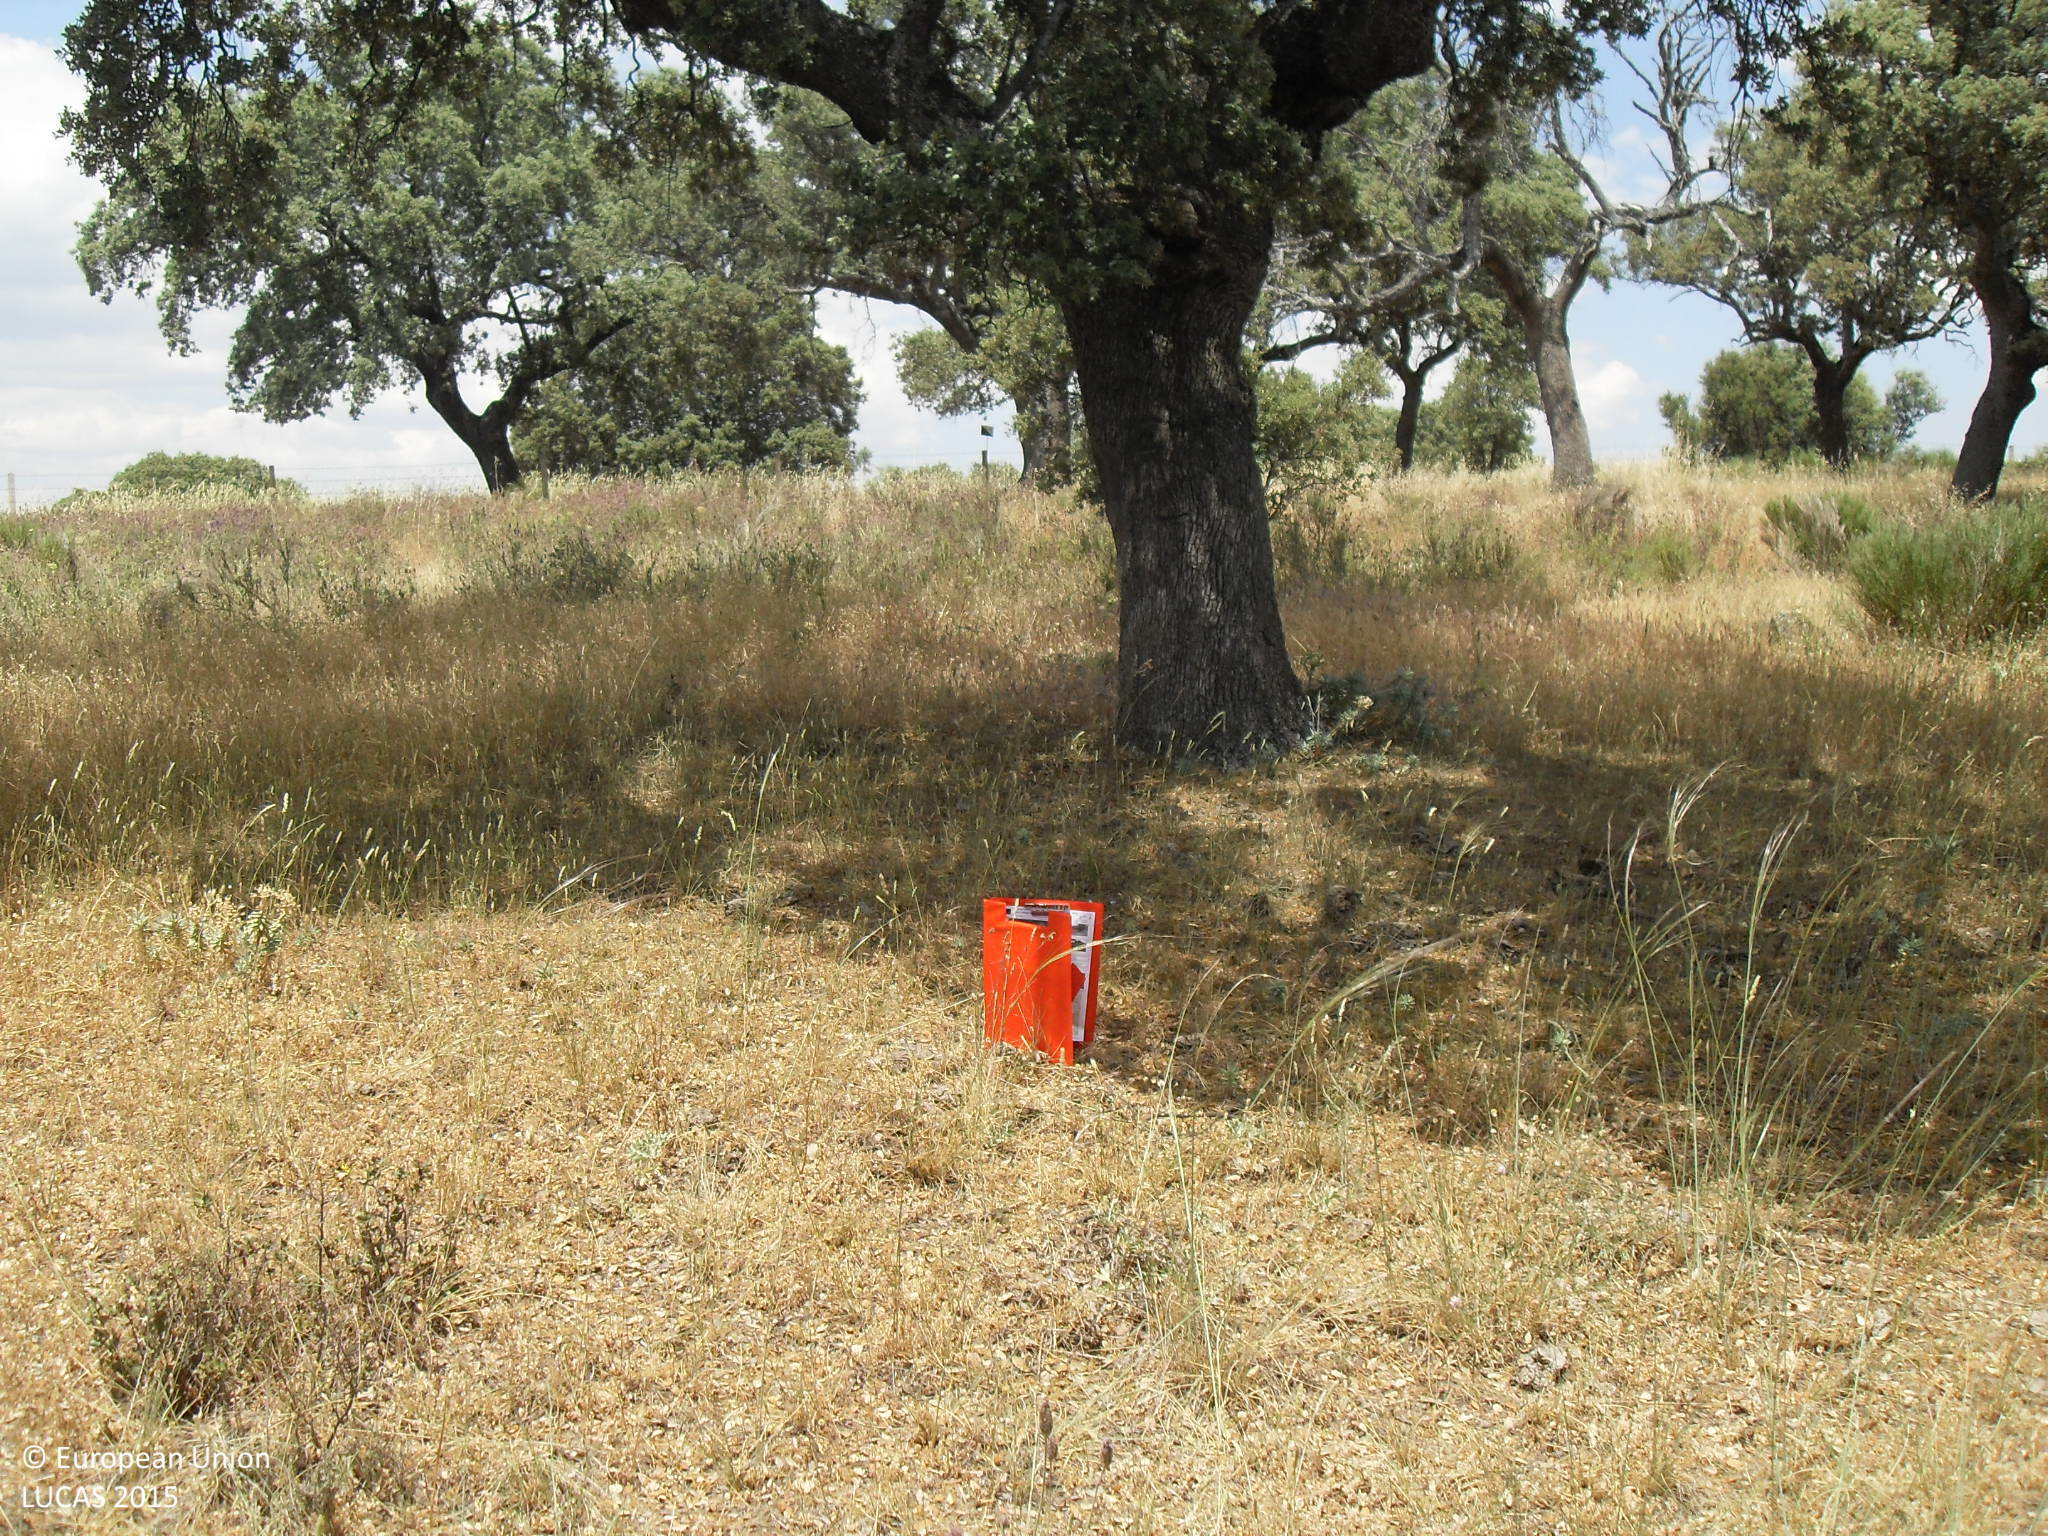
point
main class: Woodland
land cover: Broadleaved woodland
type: broadleaved evergreen forest
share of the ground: 25 - 50 %
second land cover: Grassland without tree/shrub cover
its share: 50 - 75 %
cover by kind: herbaceous plants 65 %, broadleaved forest trees 35 %
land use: Forestry
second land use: Agriculture (excluding fallow land and kitchen gardens)
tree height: > 5 m
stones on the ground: < 10 %
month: June
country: ES
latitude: 40.5095
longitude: -5.5399
